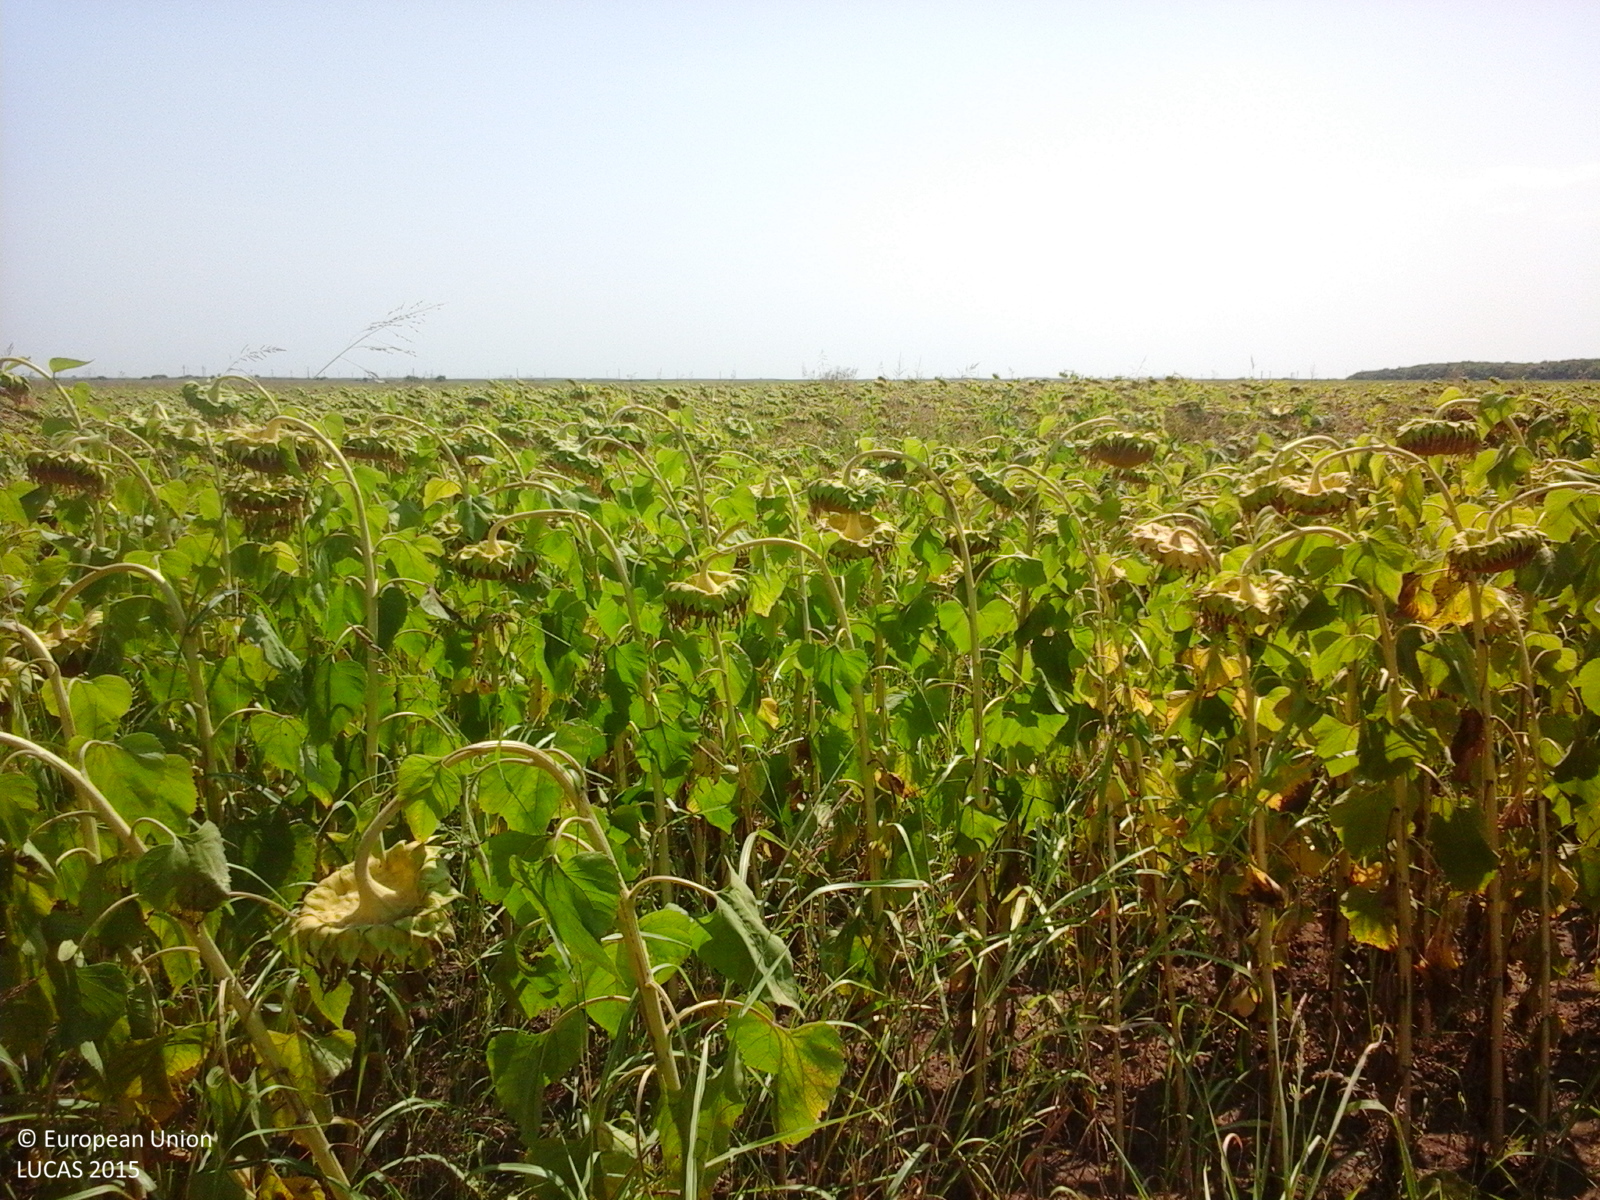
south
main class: Cropland
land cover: Sunflower
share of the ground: > 75 %
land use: Agriculture (excluding fallow land and kitchen gardens)
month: August
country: RO
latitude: 45.2903
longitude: 27.7678
